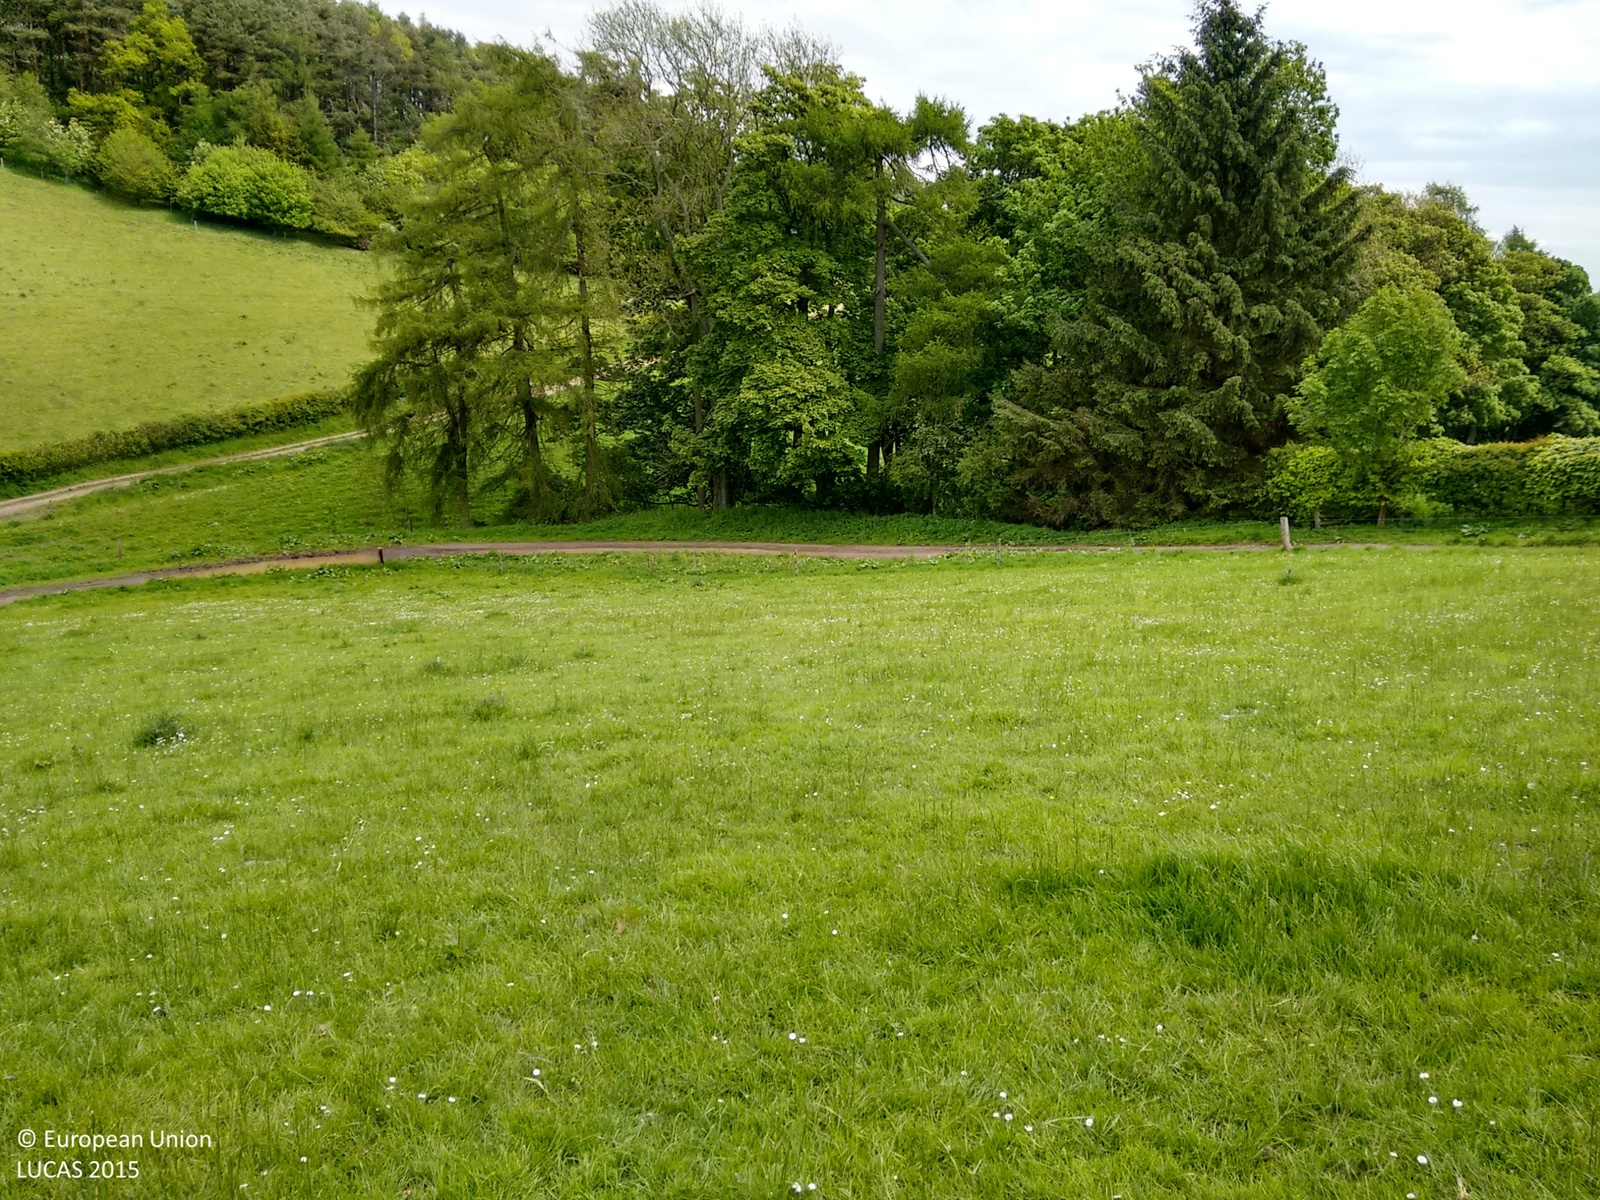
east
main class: Grassland
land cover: Grassland without tree/shrub cover
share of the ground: > 75 %
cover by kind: herbaceous plants 100 %
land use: Agriculture (excluding fallow land and kitchen gardens)
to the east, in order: Grassland without tree/shrub cover; Fences; Tracks; Broadleaved woodland; Rivers and streams; Broadleaved woodland; Fences; Grassland without tree/shrub cover; Fences; Grass margins; Tracks; Grassland without tree/shrub cover
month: June
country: GB
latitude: 56.2939
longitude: -3.3054
